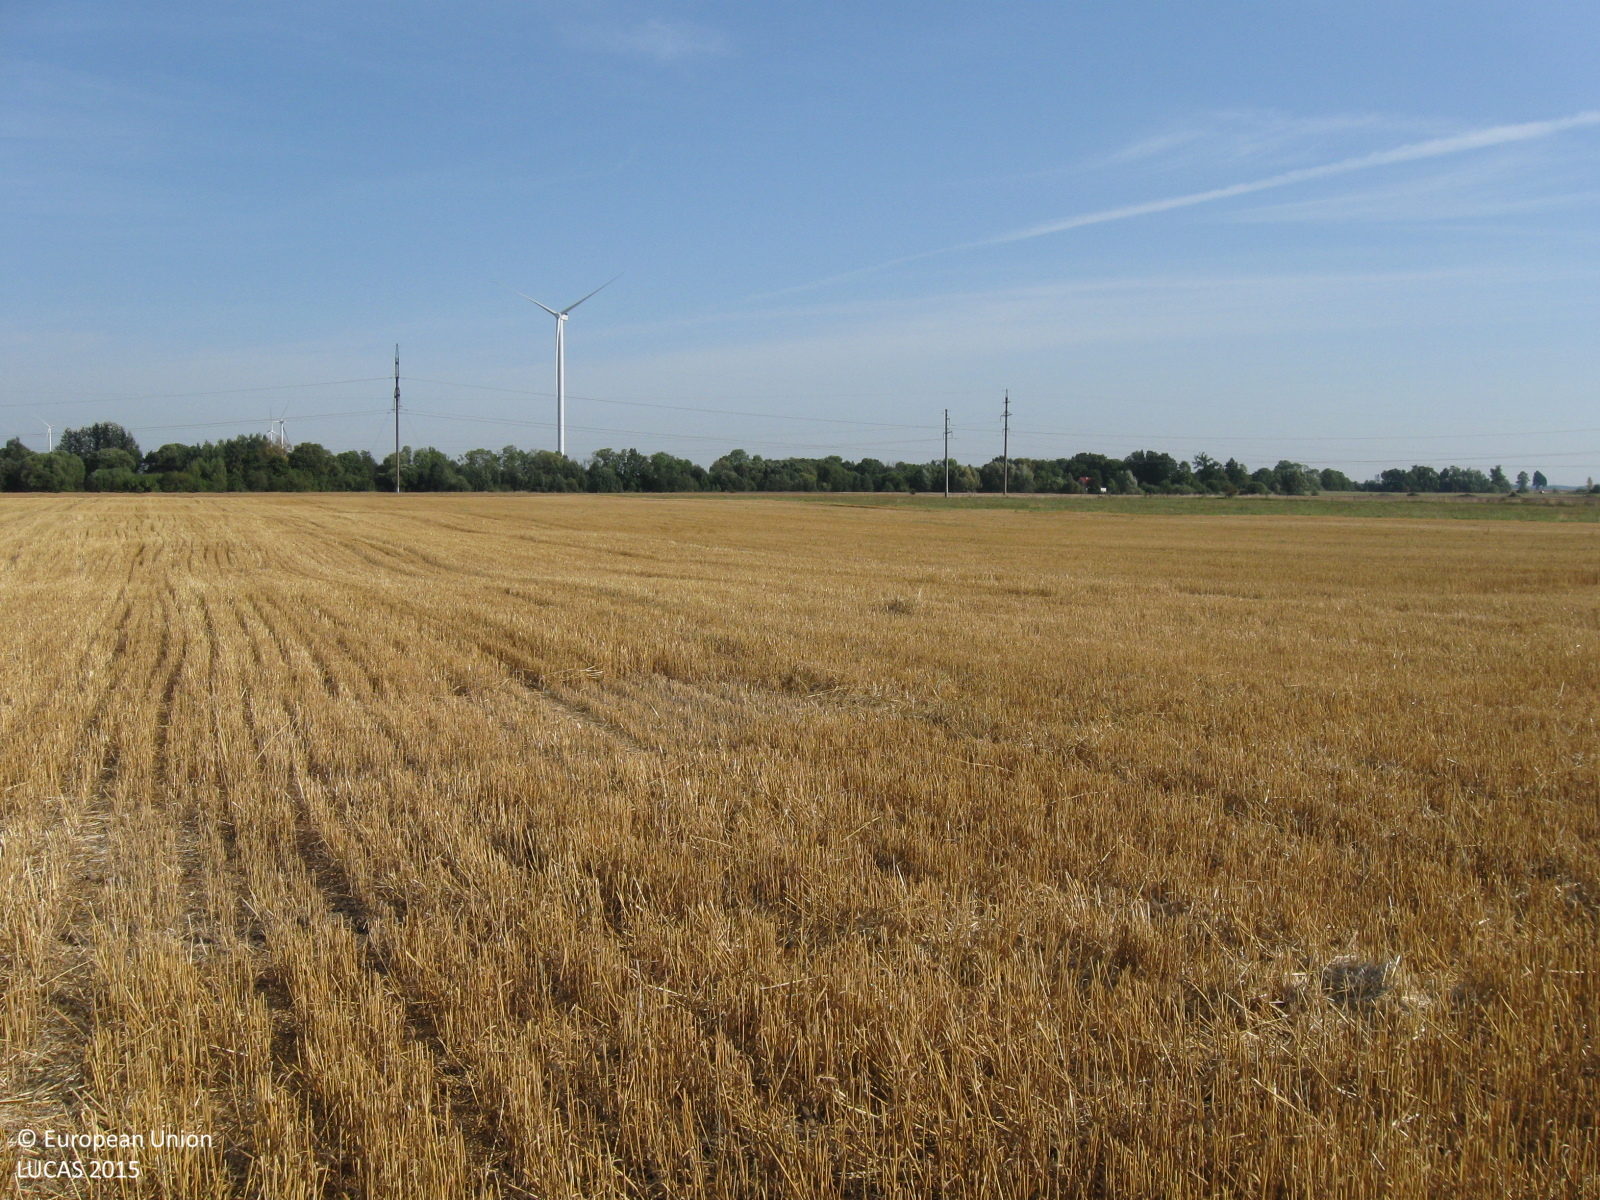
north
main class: Cropland
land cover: Common wheat
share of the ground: > 75 %
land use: Agriculture (excluding fallow land and kitchen gardens)
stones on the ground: < 10 %
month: August
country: LT
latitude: 55.1016
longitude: 22.8413
